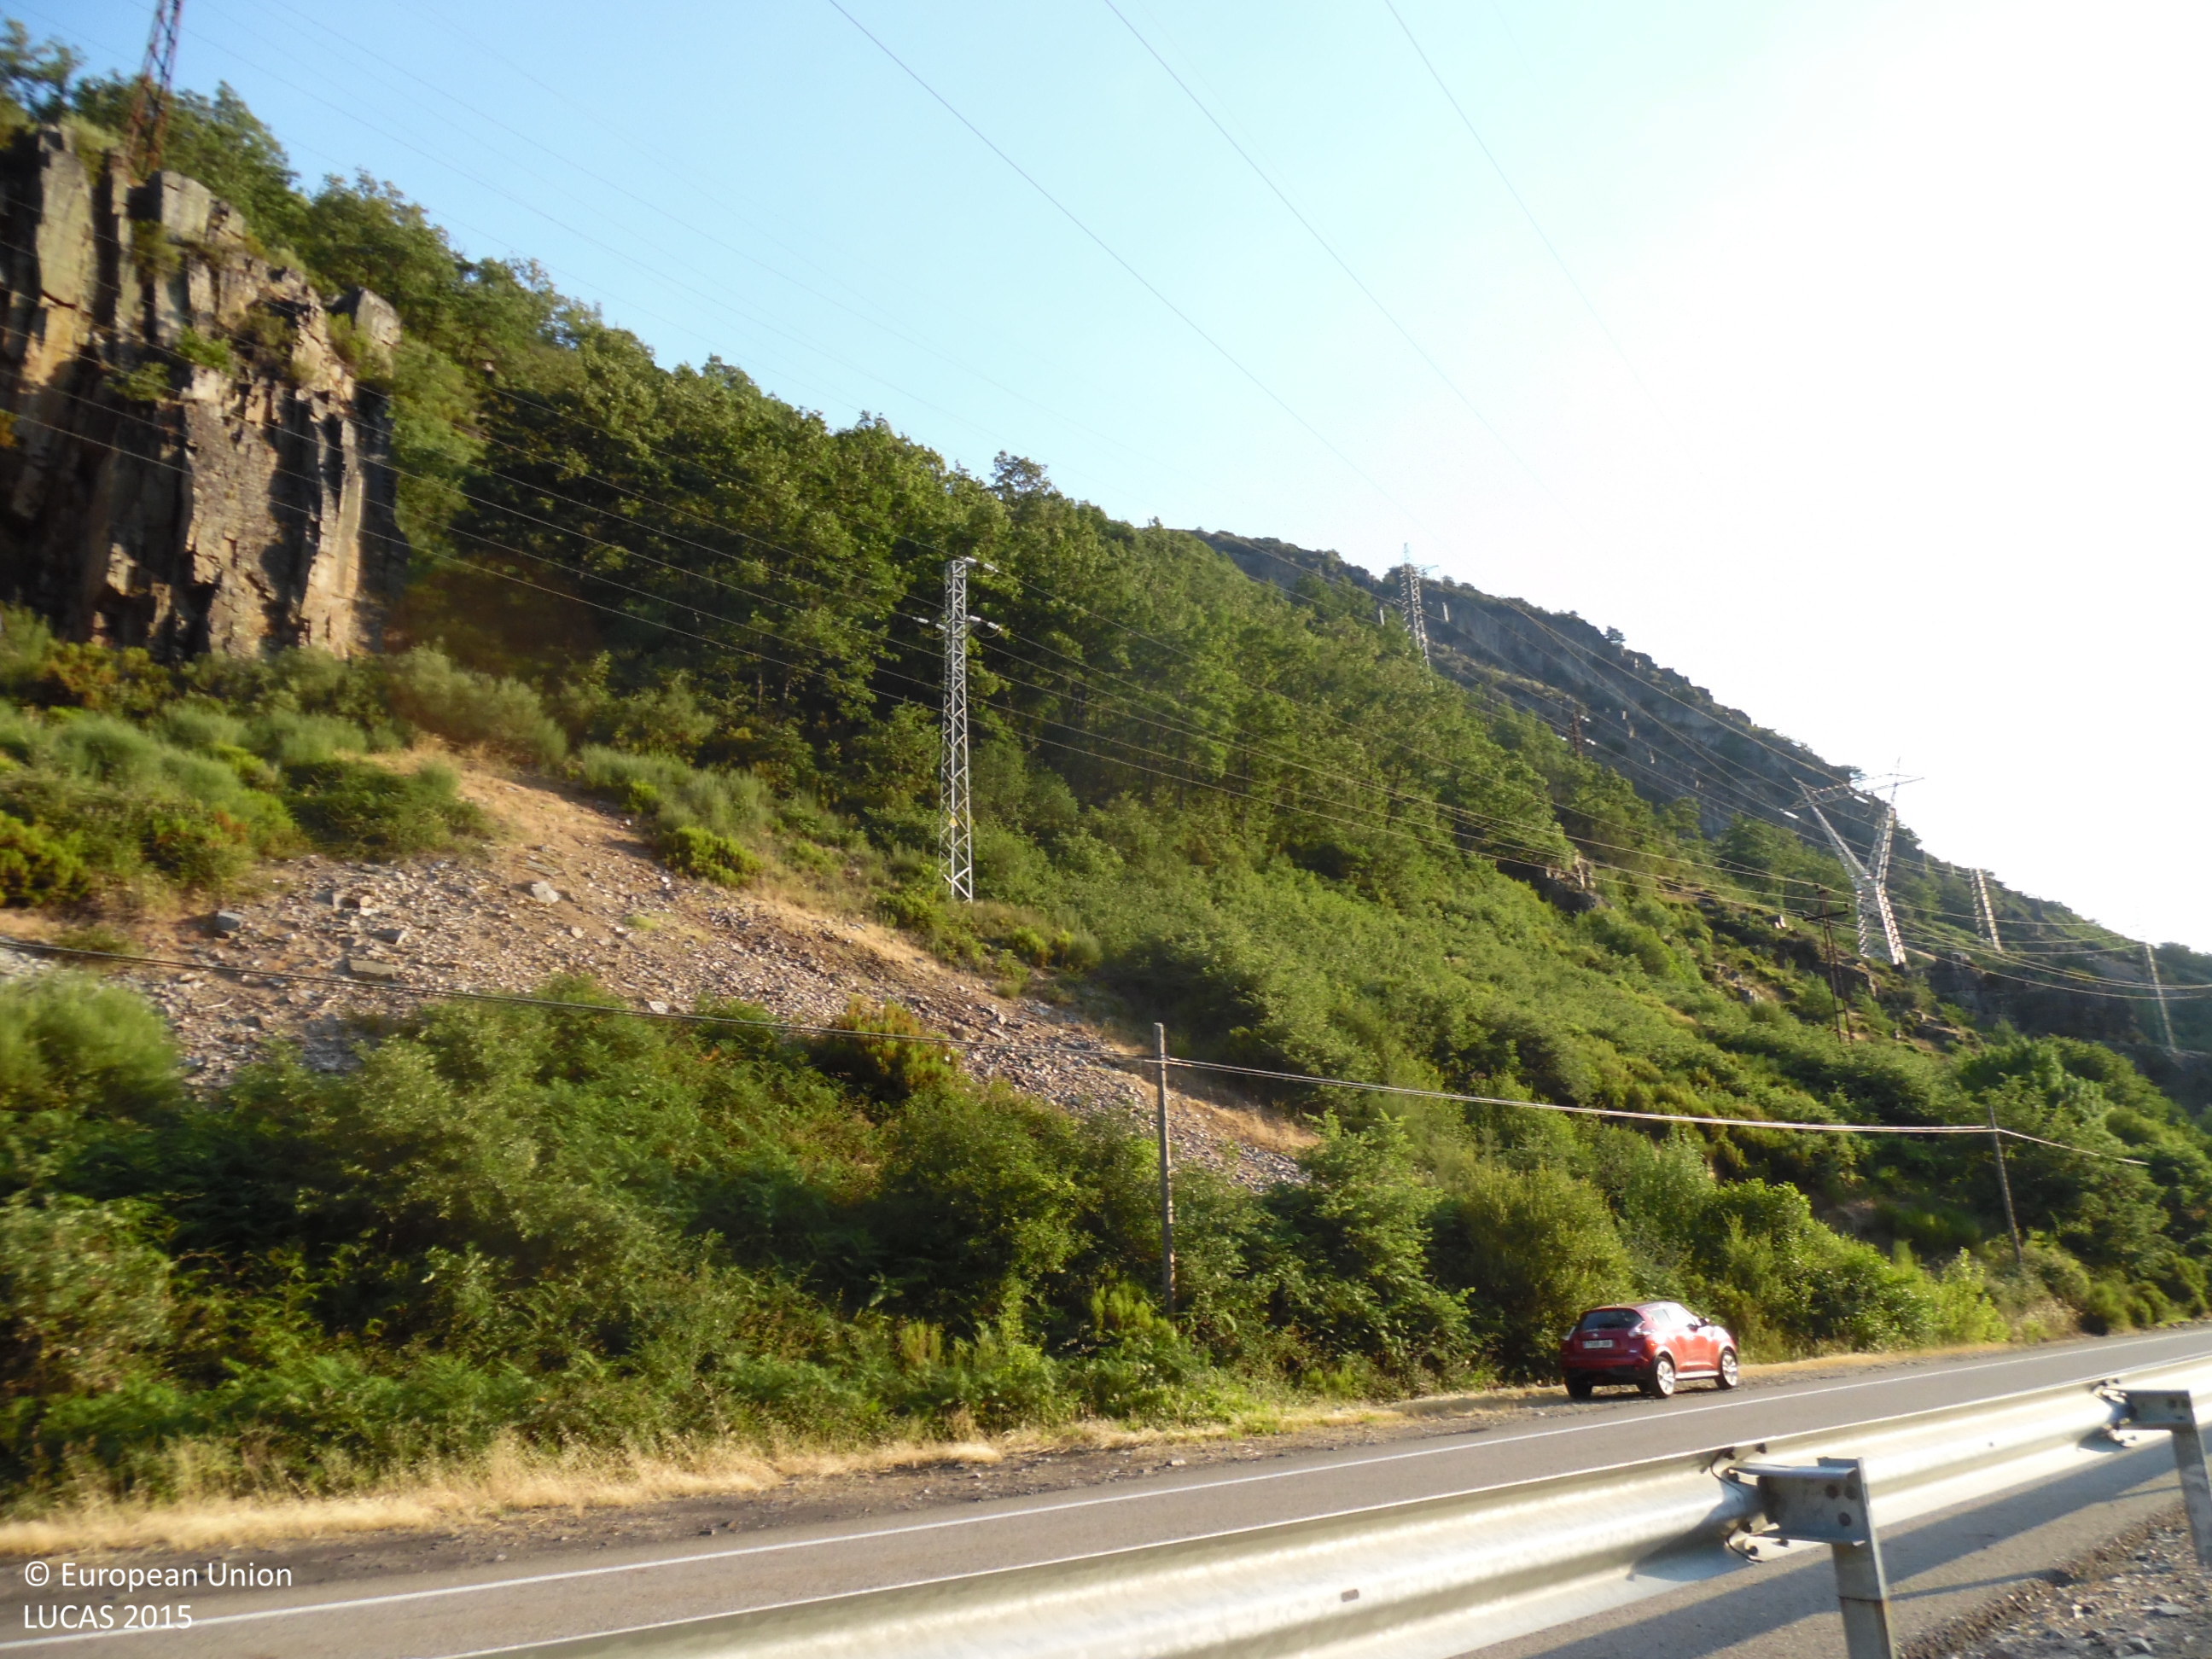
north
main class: Woodland
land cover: Broadleaved woodland
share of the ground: > 75 %
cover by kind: broadleaved forest trees 80 %, shrubs 5 %
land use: Forestry
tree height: > 5 m
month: June
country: ES
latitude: 42.8383
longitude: -6.4783
